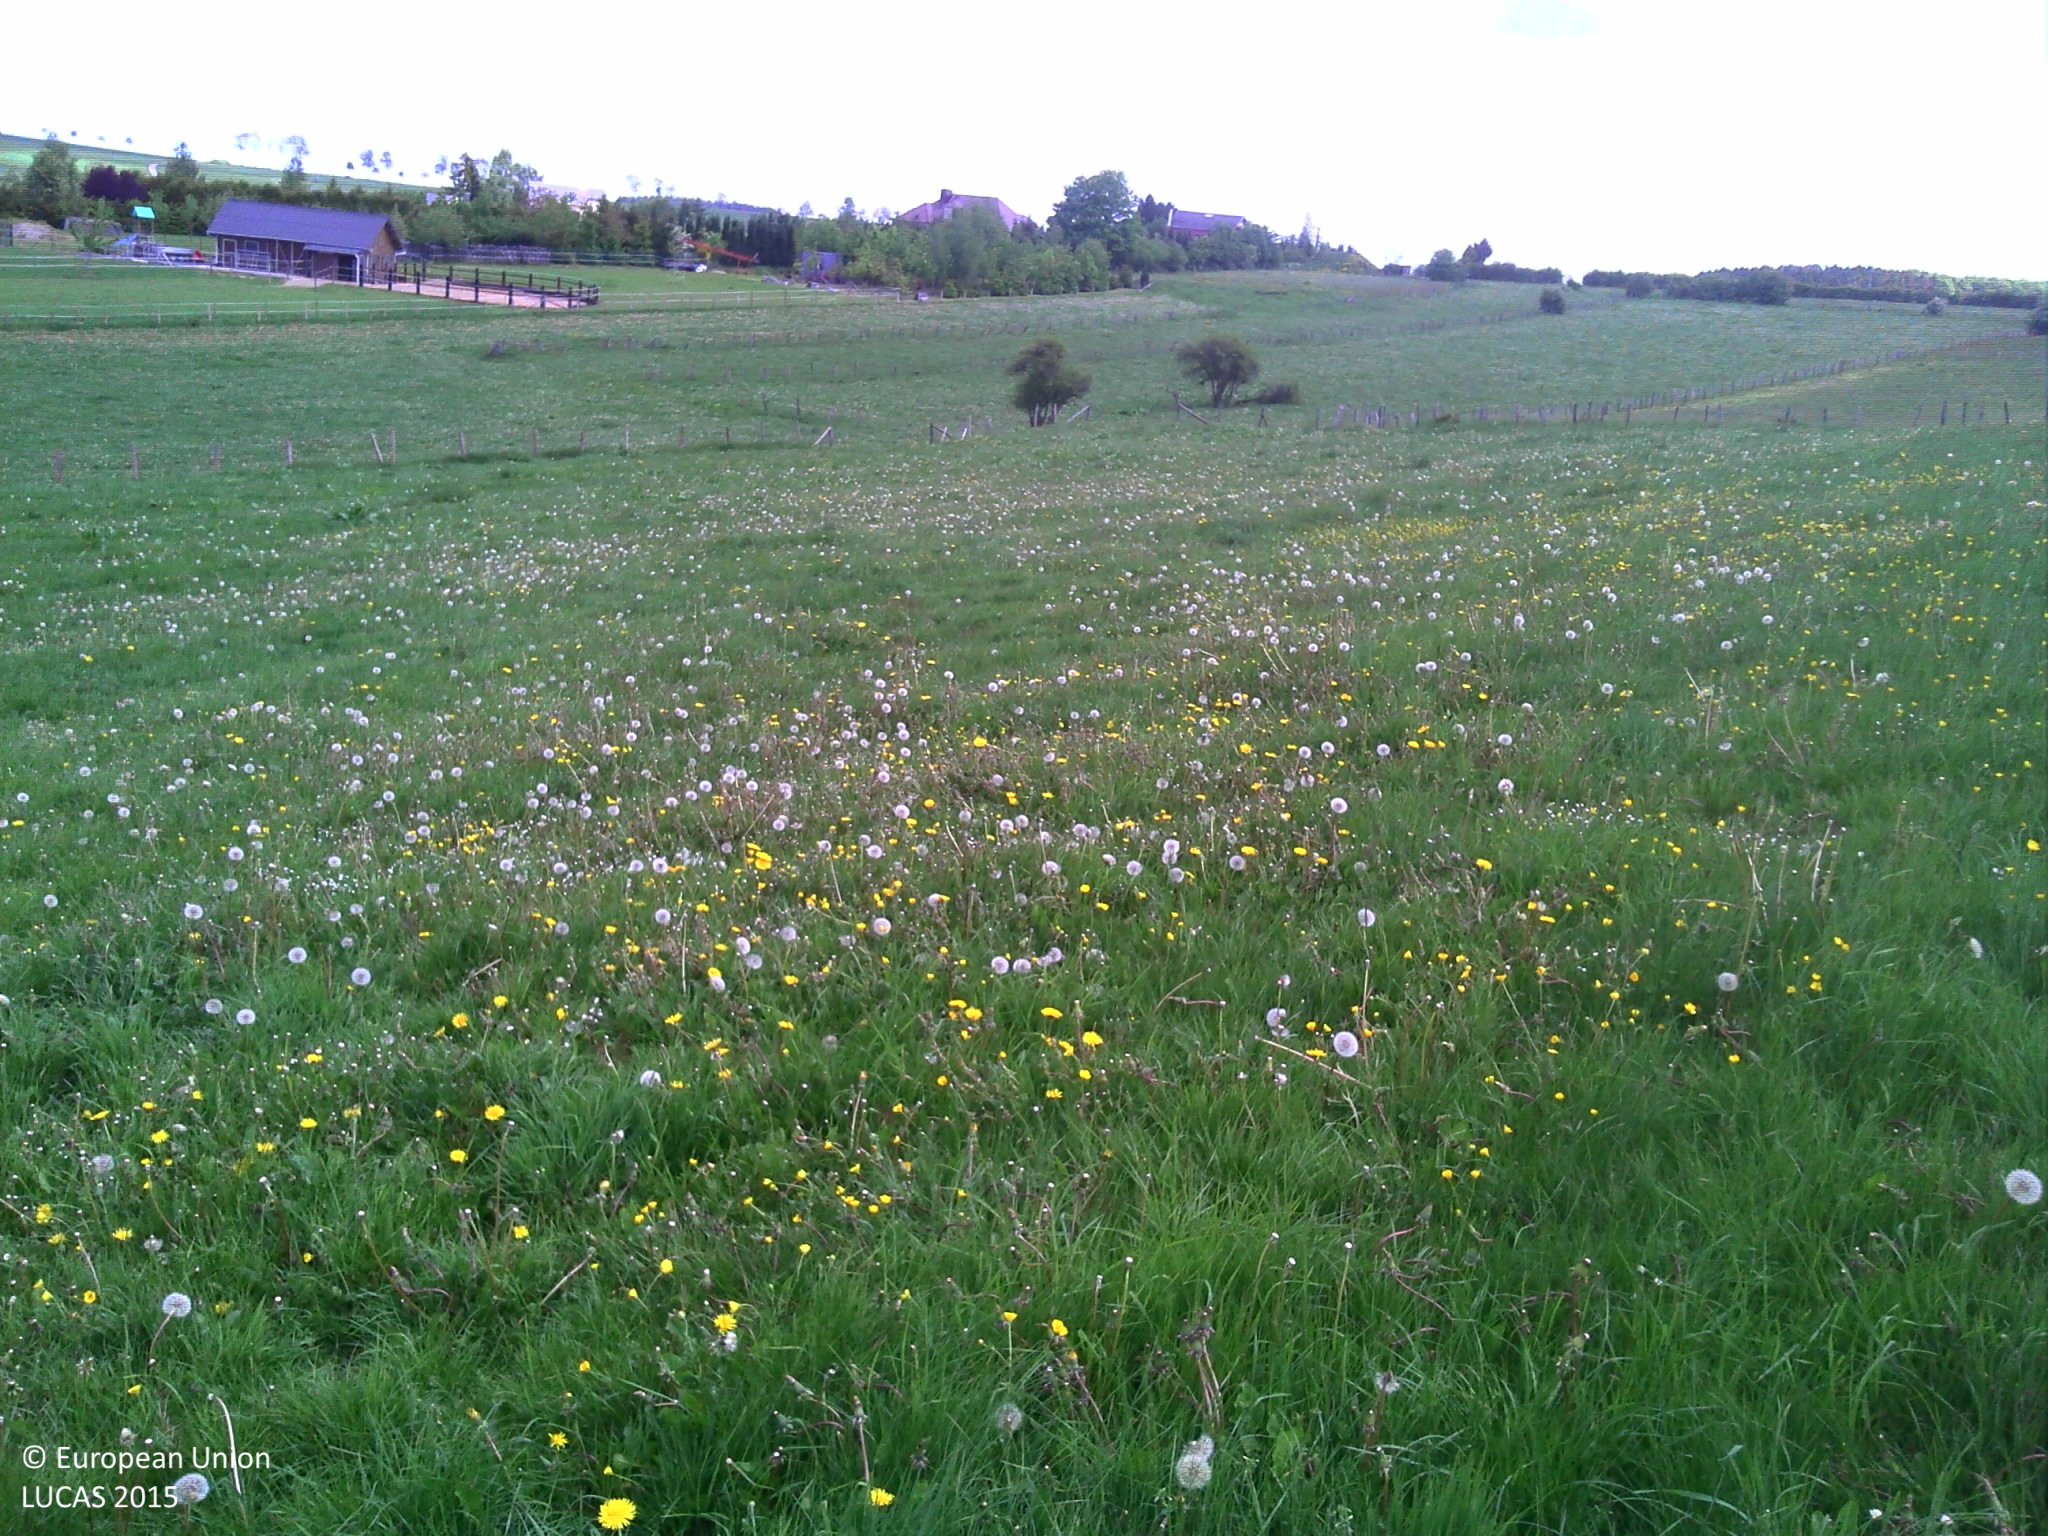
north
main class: Grassland
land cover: Grassland without tree/shrub cover
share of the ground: > 75 %
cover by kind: herbaceous plants 100 %
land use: Agriculture (excluding fallow land and kitchen gardens)
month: May
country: LU
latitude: 50.0588
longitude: 5.9622
